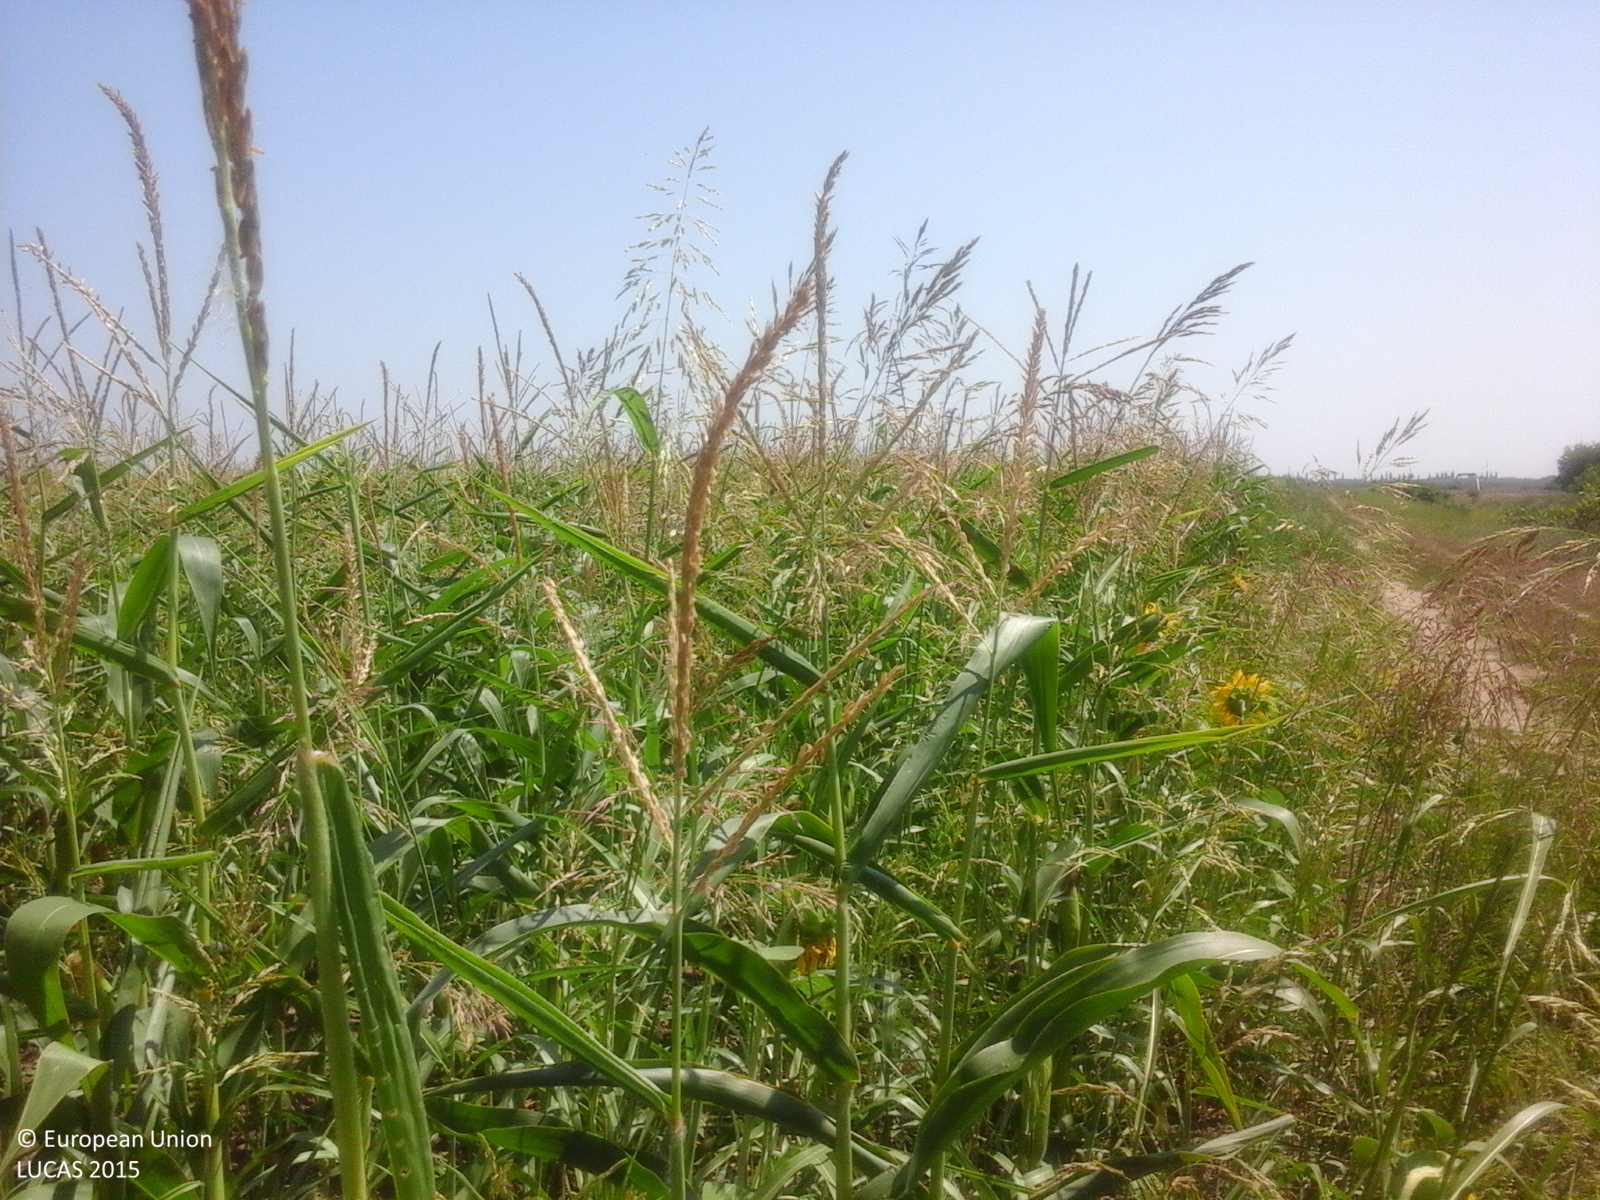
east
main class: Cropland
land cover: Maize
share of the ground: > 75 %
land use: Agriculture (excluding fallow land and kitchen gardens)
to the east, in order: Maize; Sunflower
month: July
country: RO
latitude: 44.4665
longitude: 26.7517
